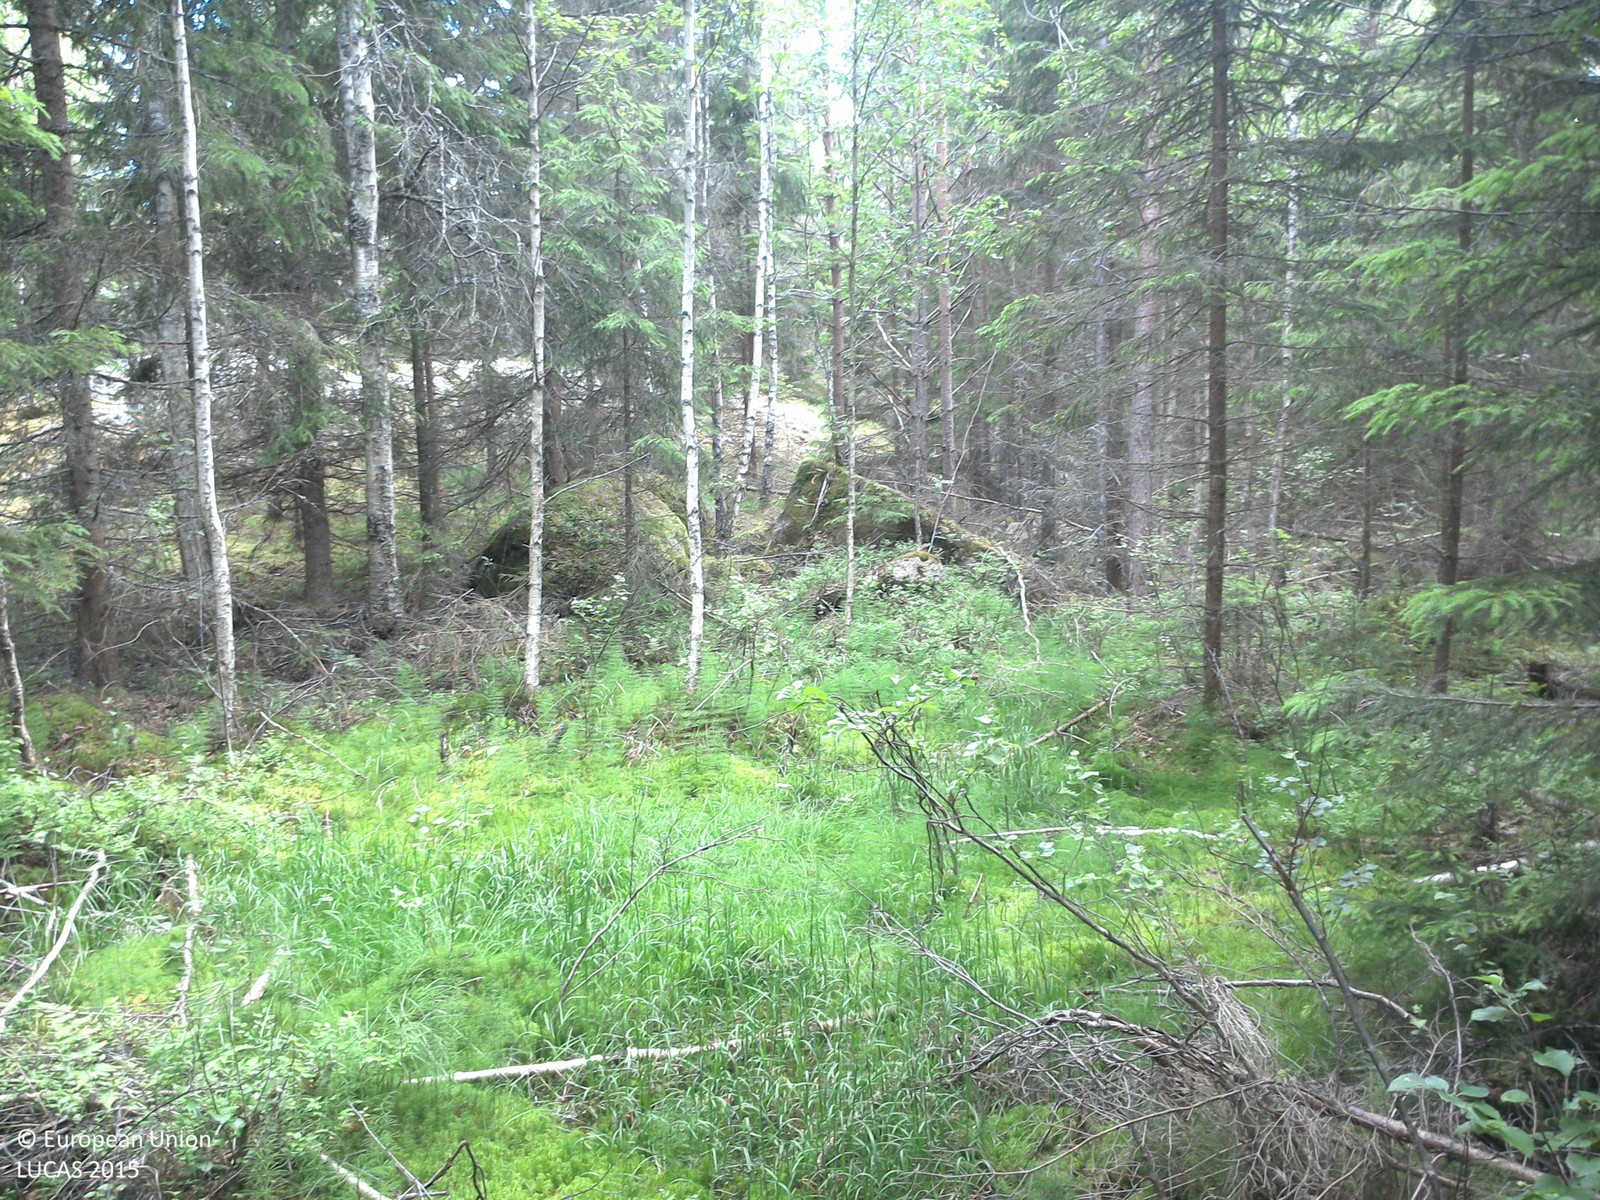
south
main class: Woodland
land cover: Spruce dominated mixed woodland
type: boreal forest
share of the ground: > 75 %
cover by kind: coniferous forest trees 60 %, broadleaved forest trees 20 %, herbaceous plants 20 %
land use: Forestry
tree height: > 5 m
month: June
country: SE
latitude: 58.0500
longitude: 15.5697
